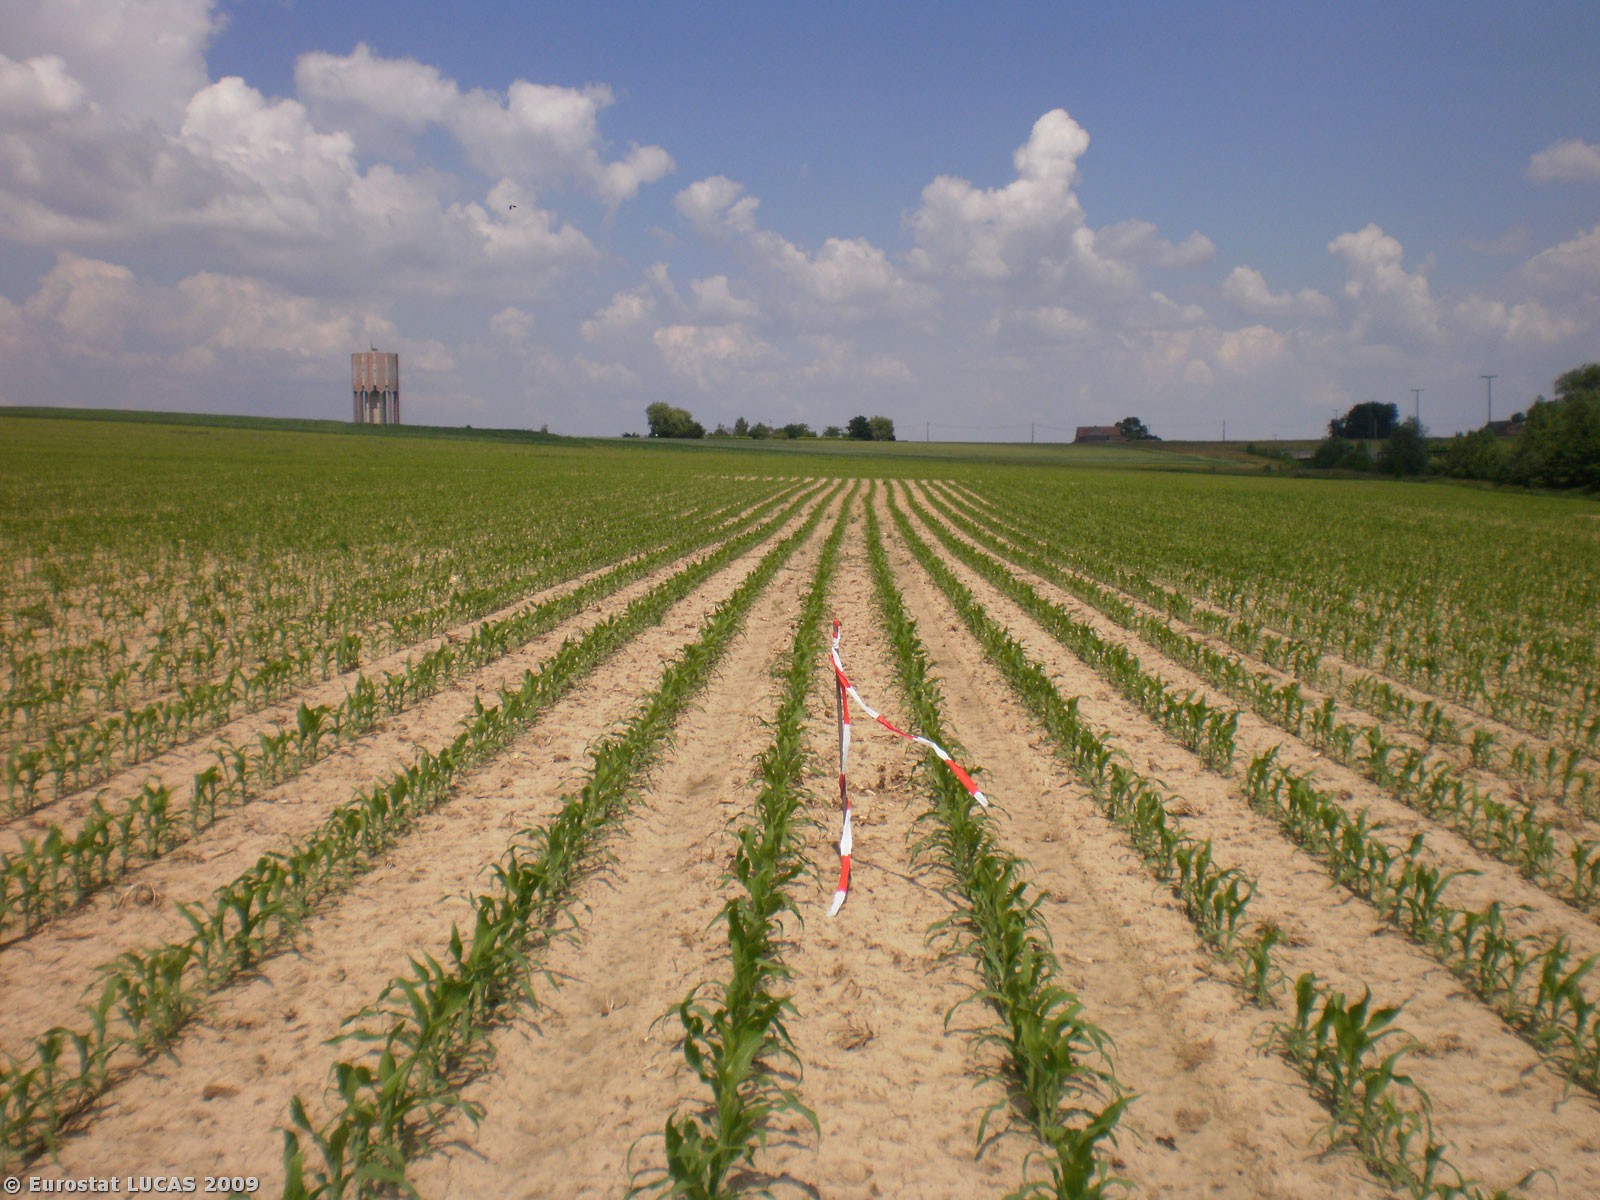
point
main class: Cropland
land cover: Maize
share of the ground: 10 - 25 %
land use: Agriculture (excluding fallow land and kitchen gardens)
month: June
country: BE
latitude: 50.6623
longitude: 3.7544
